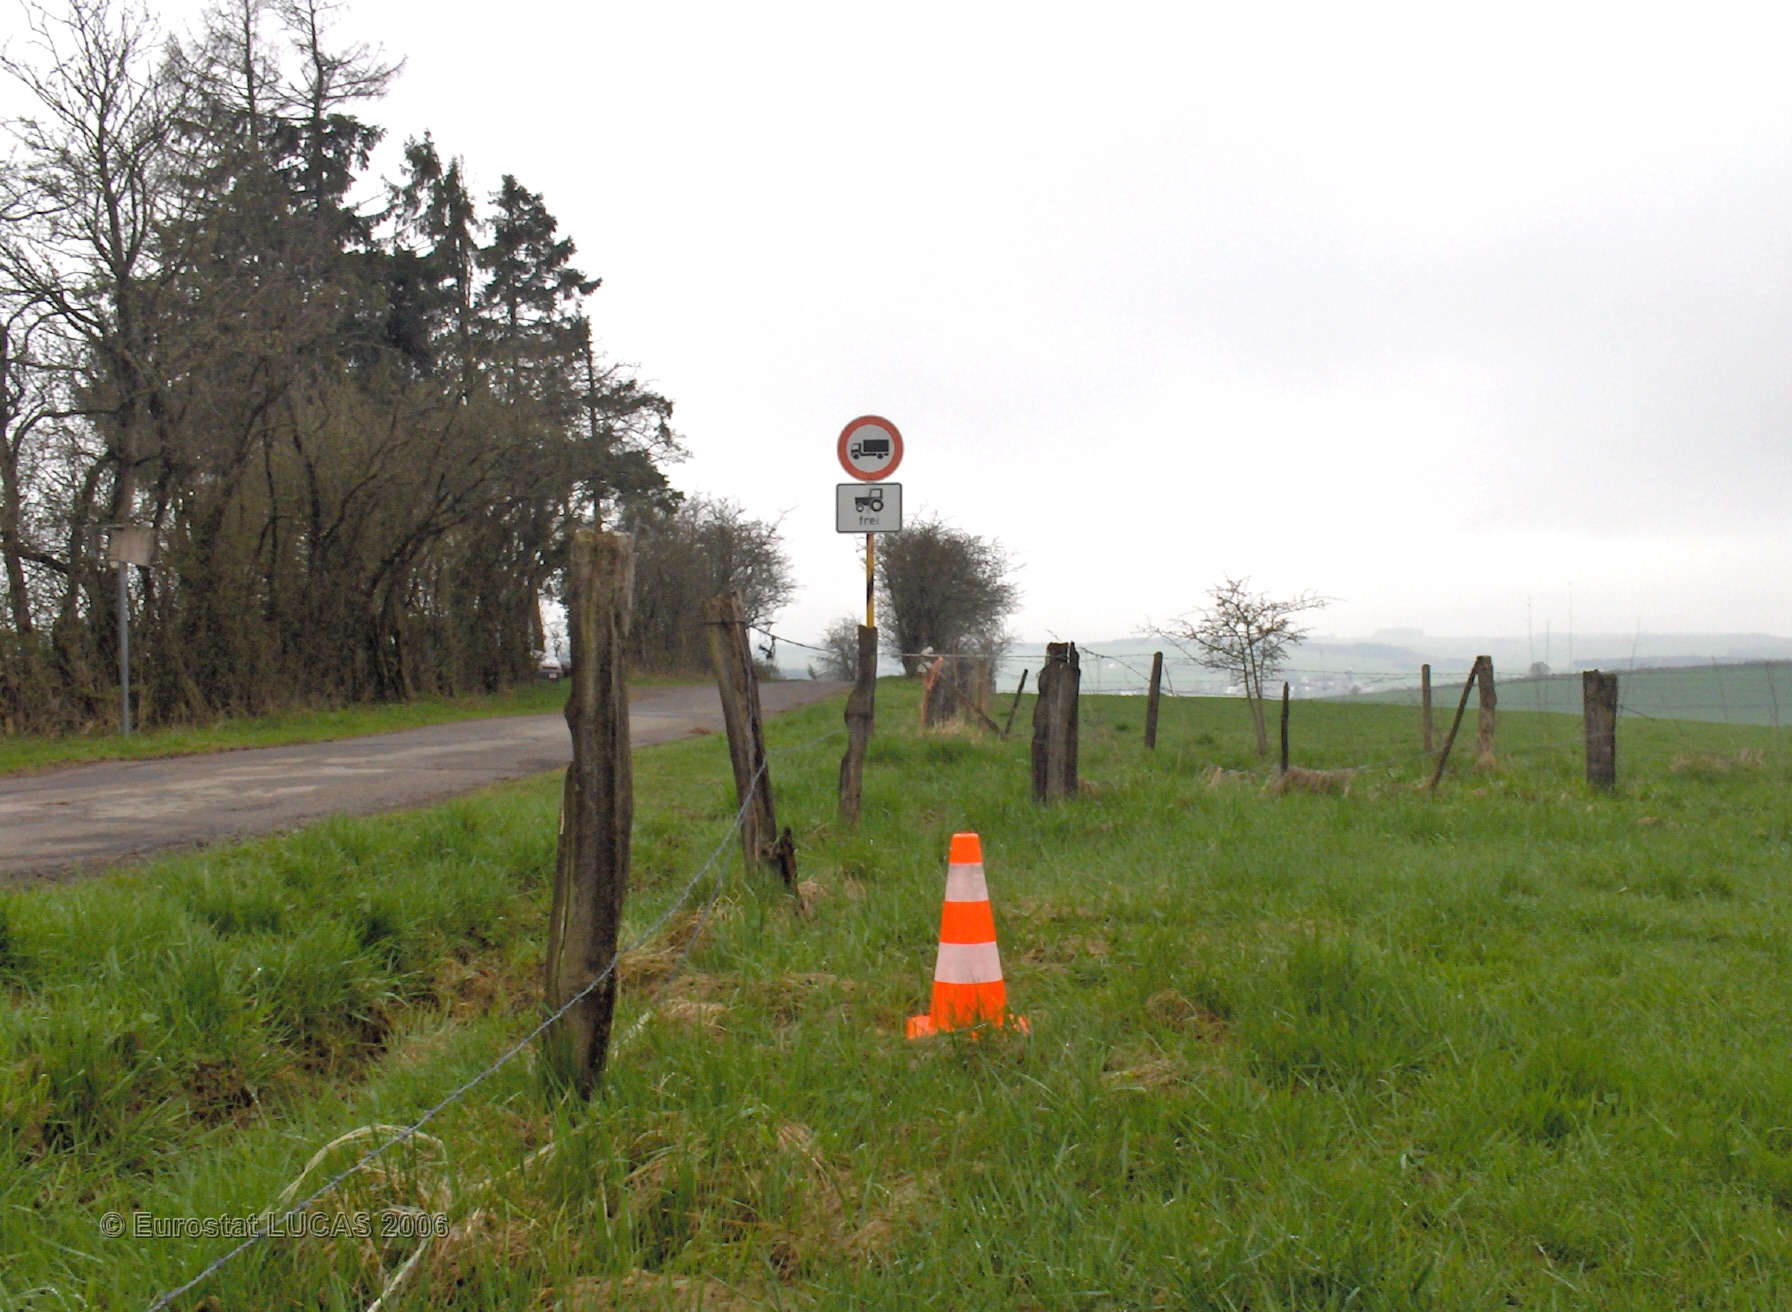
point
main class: Grassland
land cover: Grassland without tree/shrub cover
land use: Agriculture (excluding fallow land and kitchen gardens)
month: May
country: BE
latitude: 50.3233
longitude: 6.3335
